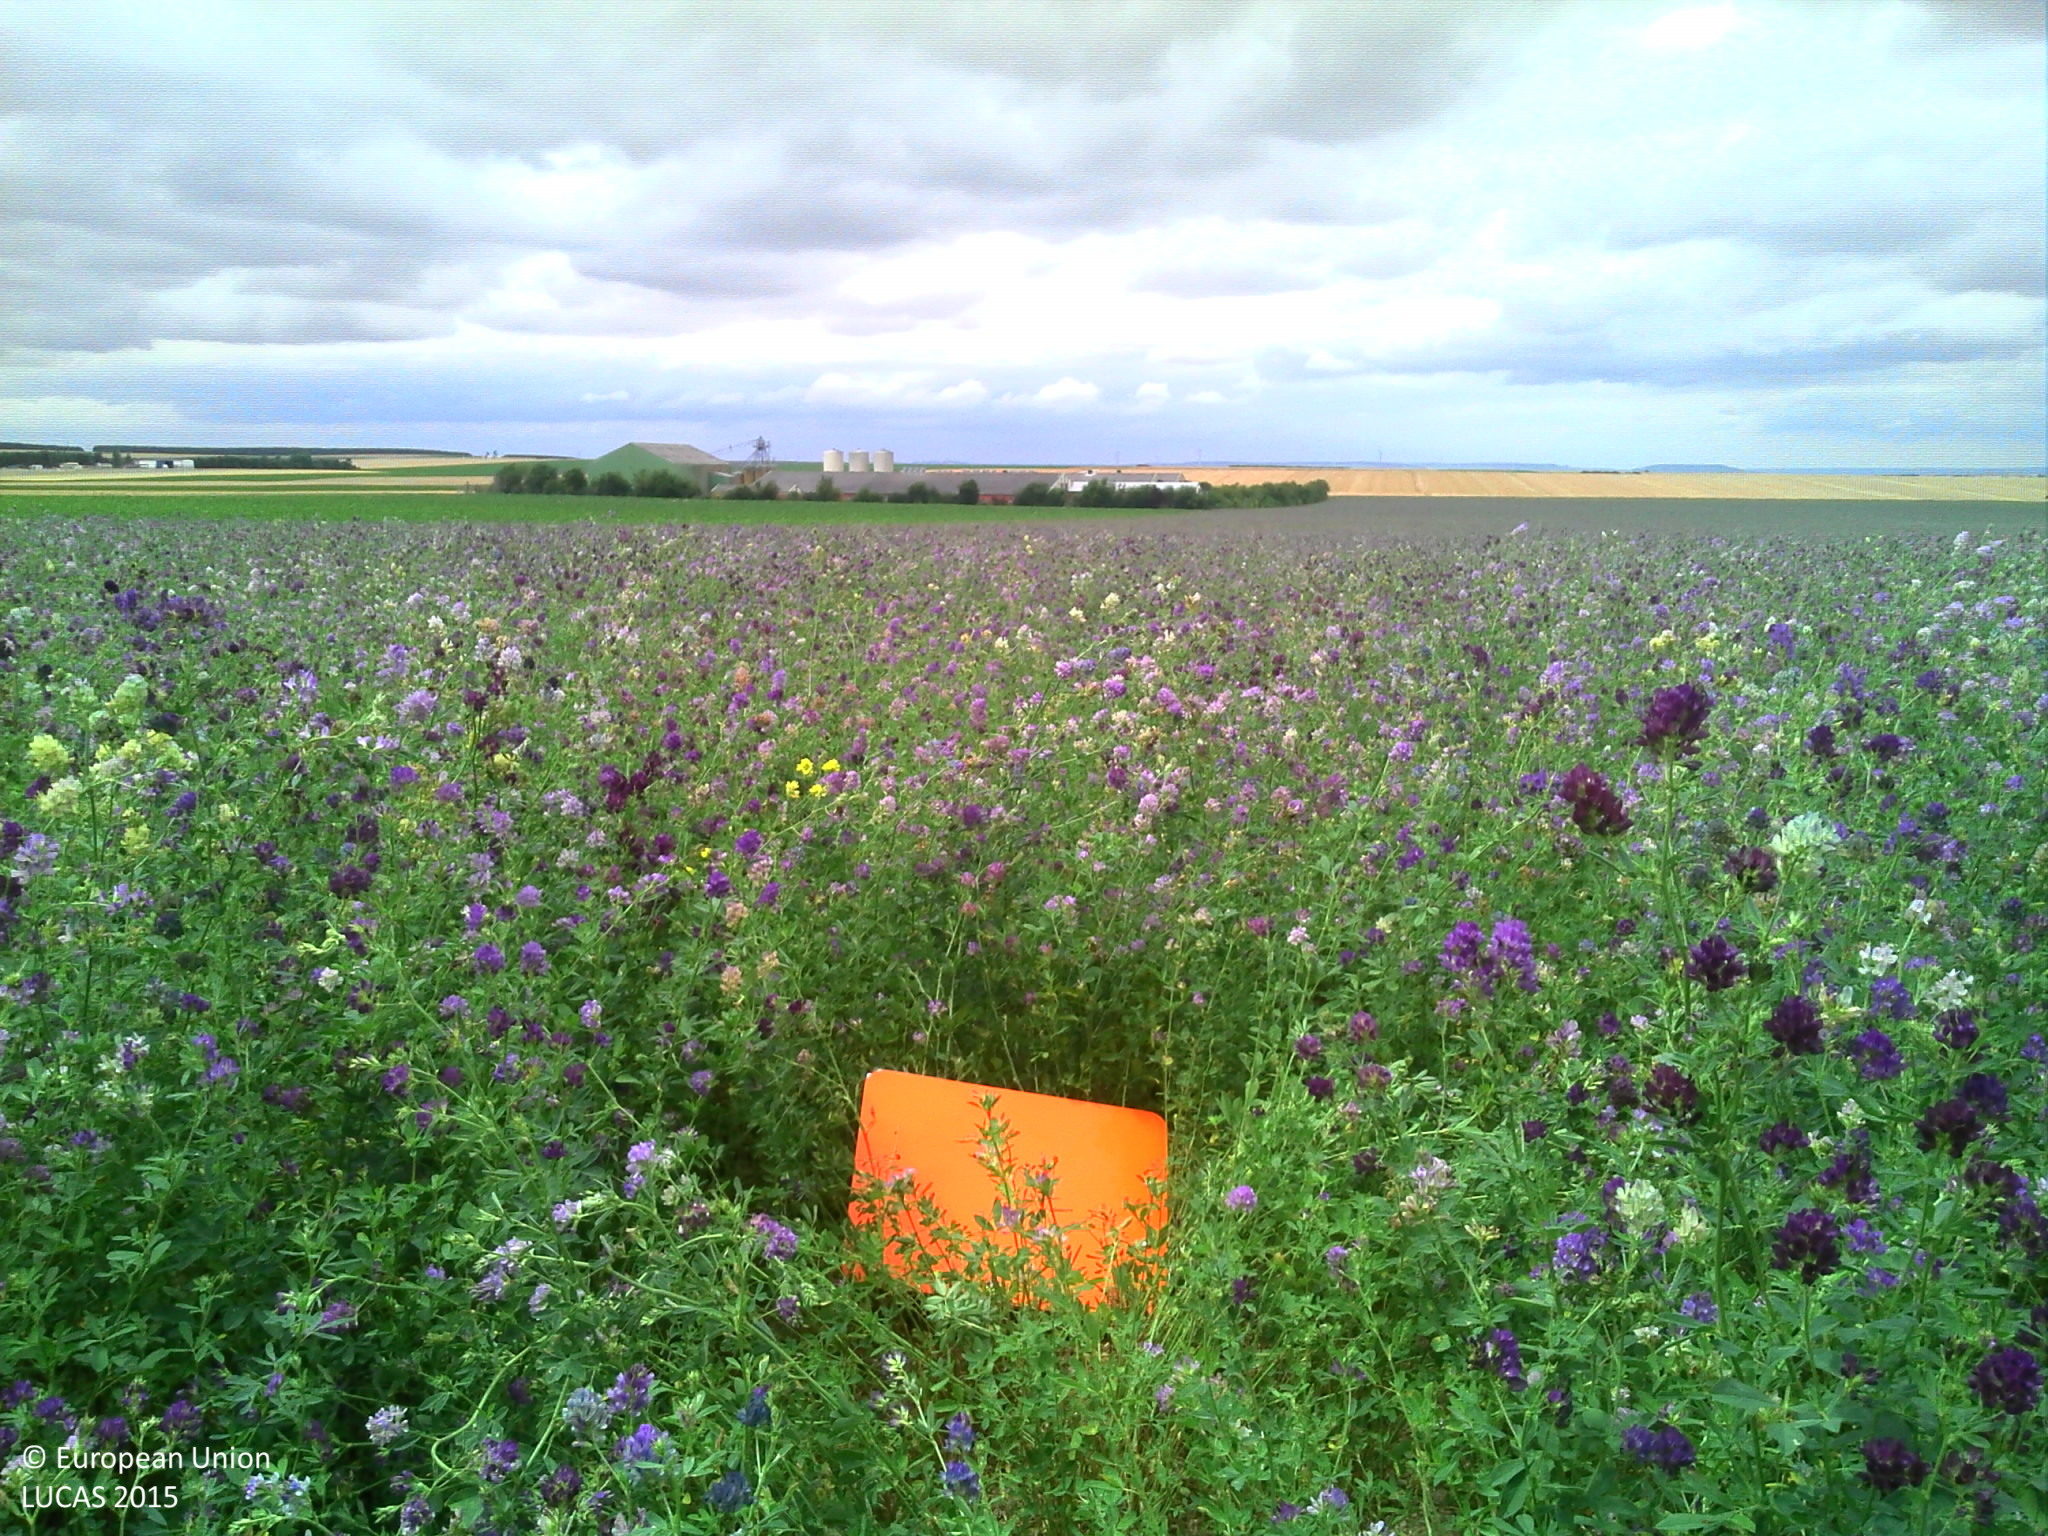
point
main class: Cropland
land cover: Lucerne
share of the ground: > 75 %
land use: Agriculture (excluding fallow land and kitchen gardens)
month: July
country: FR
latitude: 48.8109
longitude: 4.2087
